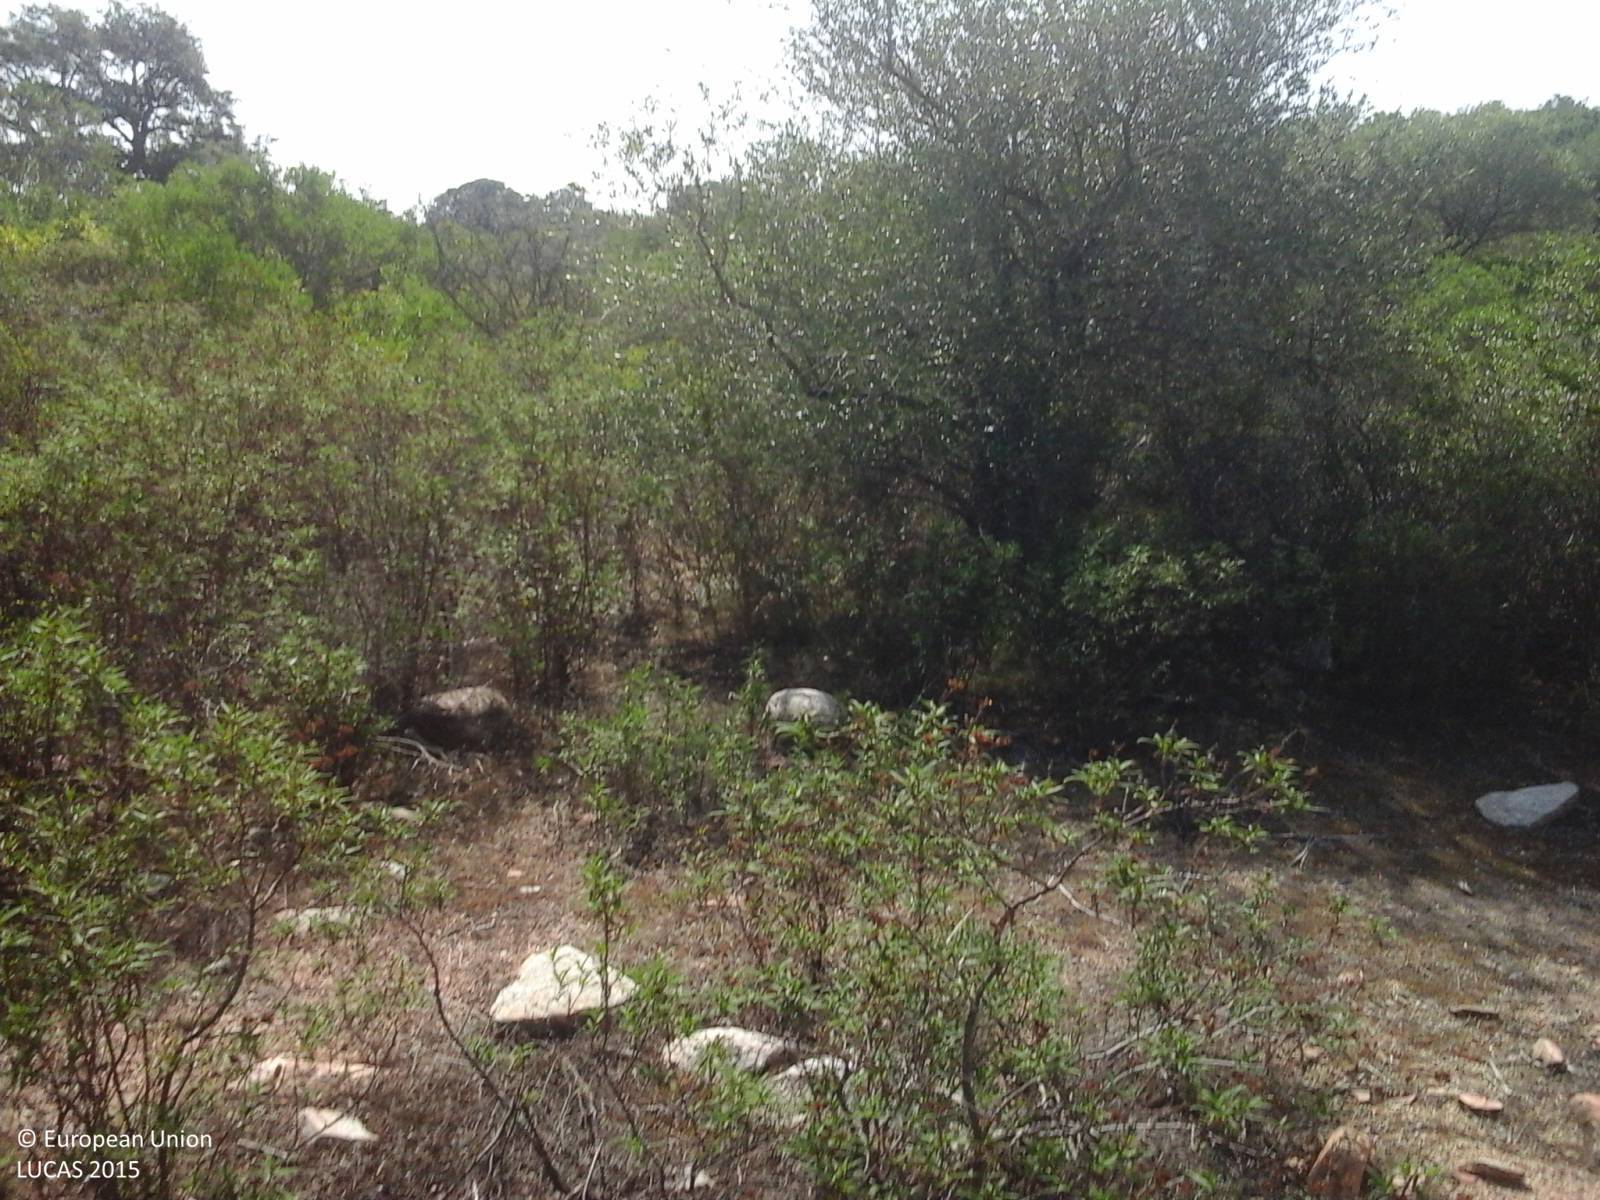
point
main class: Shrubland
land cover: Shrubland with sparse tree cover
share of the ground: > 75 %
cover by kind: shrubs 55 %, consolidated bare surface 30 %, broadleaved forest trees 5 %, herbaceous plants 5 %, unconsolidated bare surface 5 %
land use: Semi-natural and natural areas not in use
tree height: > 5 m
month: September
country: IT
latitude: 40.0130
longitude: 9.5922
